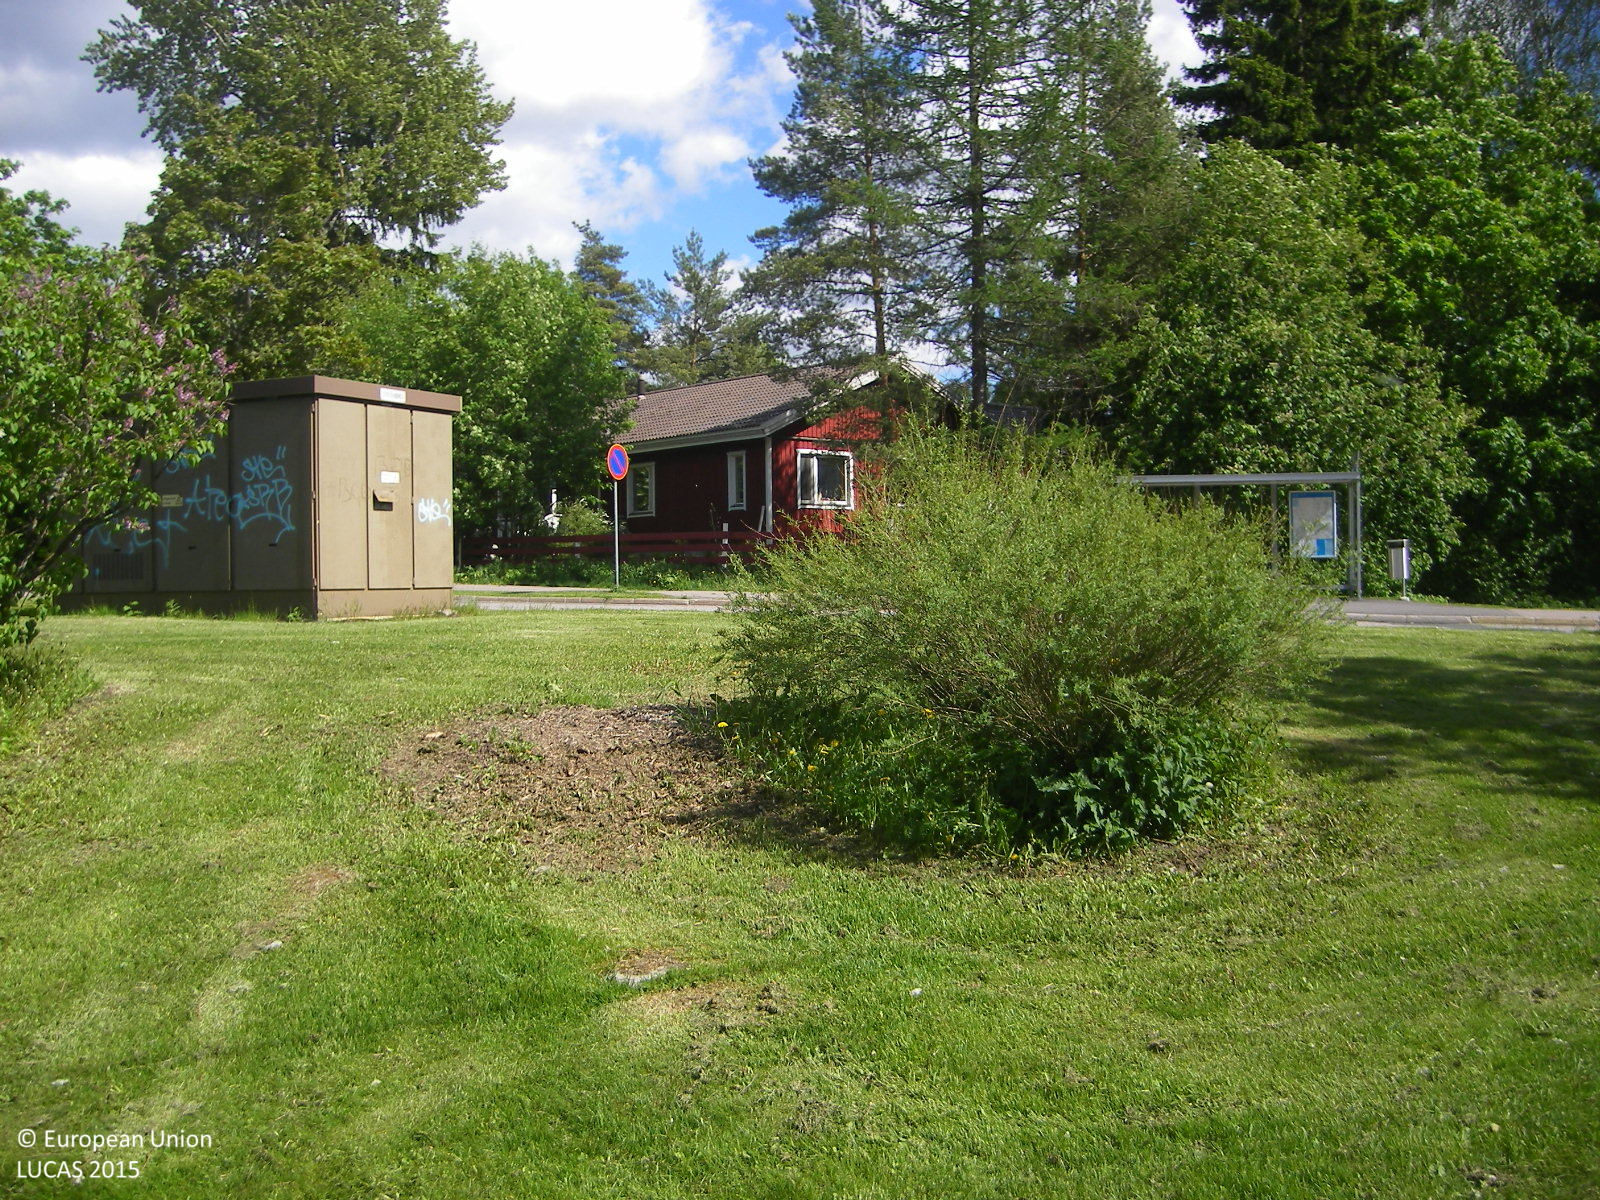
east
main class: Grassland
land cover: Grassland with sparse tree/shrub cover
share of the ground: > 75 %
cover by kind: herbaceous plants 90 %, broadleaved forest trees 5 %, shrubs 5 %
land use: Amenities, museums, leisure
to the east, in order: Grassland with sparse tree/shrub cover; Artificial constructions in urban areas
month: June
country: FI
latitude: 60.2775
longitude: 24.7783
